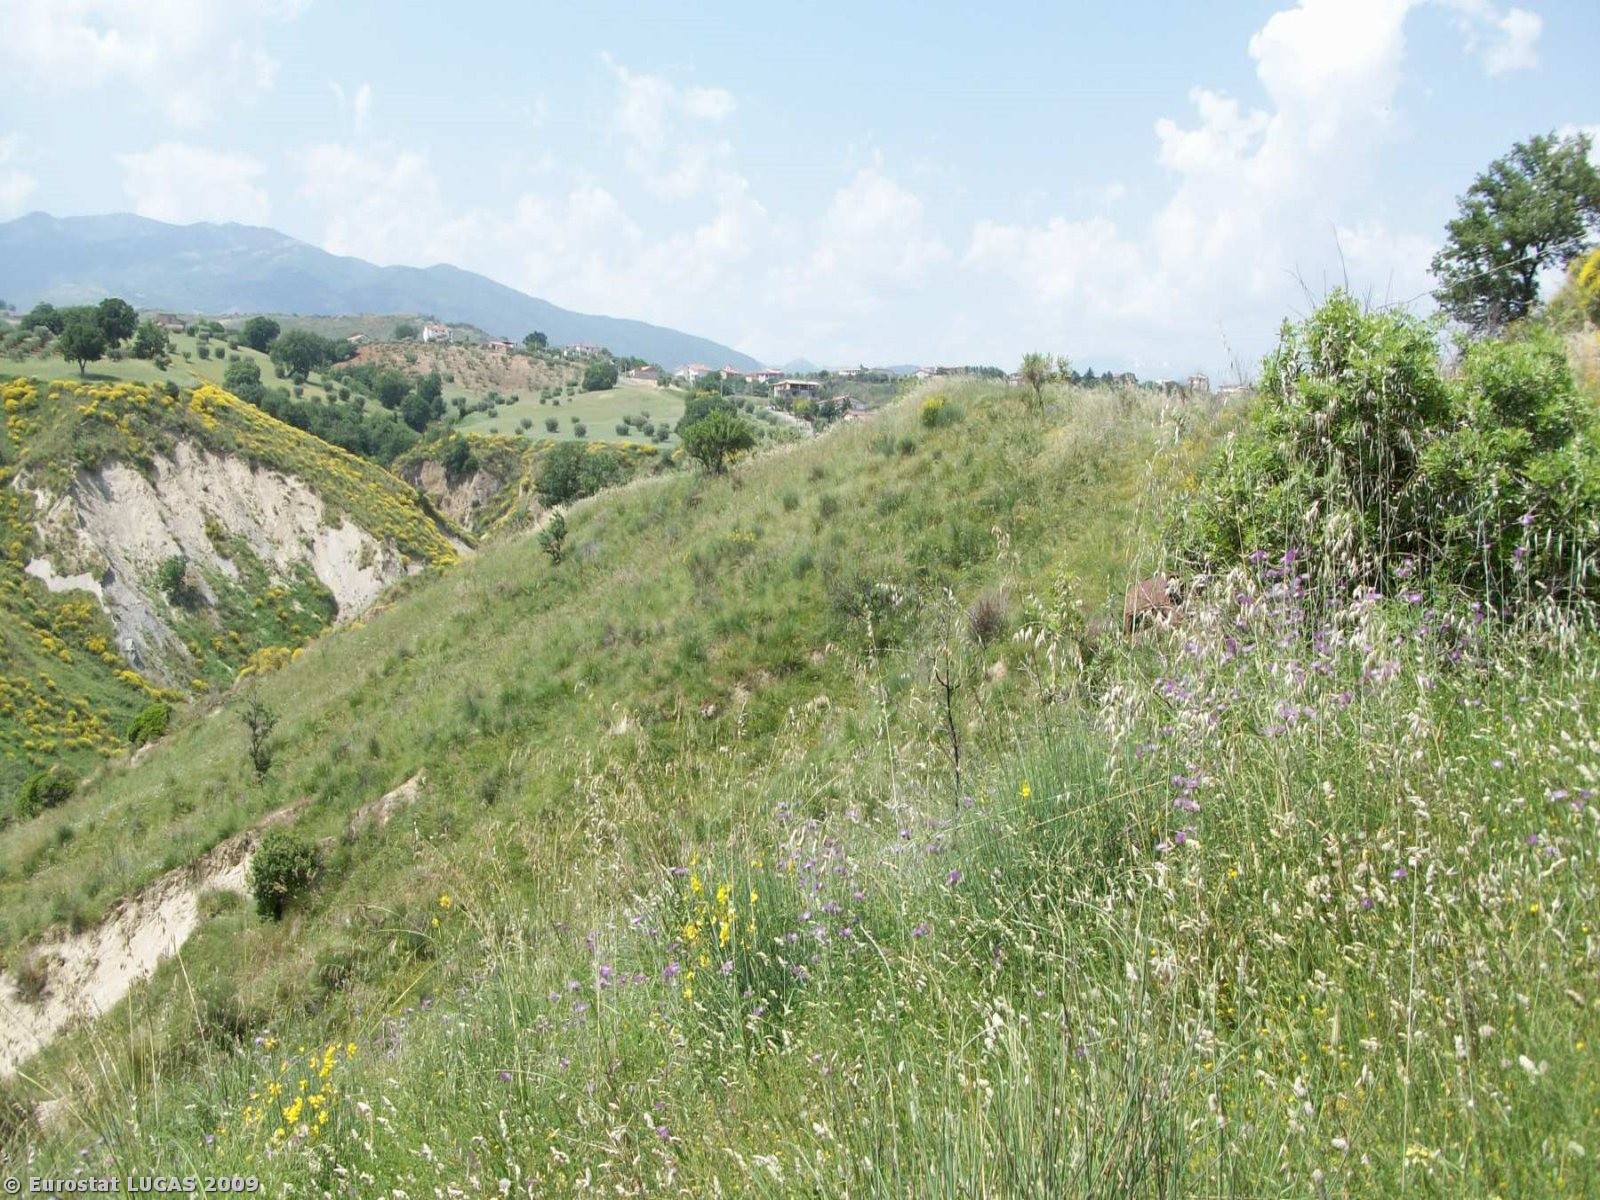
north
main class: Shrubland
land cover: Shrubland with sparse tree cover
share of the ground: > 75 %
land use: Fallow land
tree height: < 5 m
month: May
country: IT
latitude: 39.7103
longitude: 16.1656
